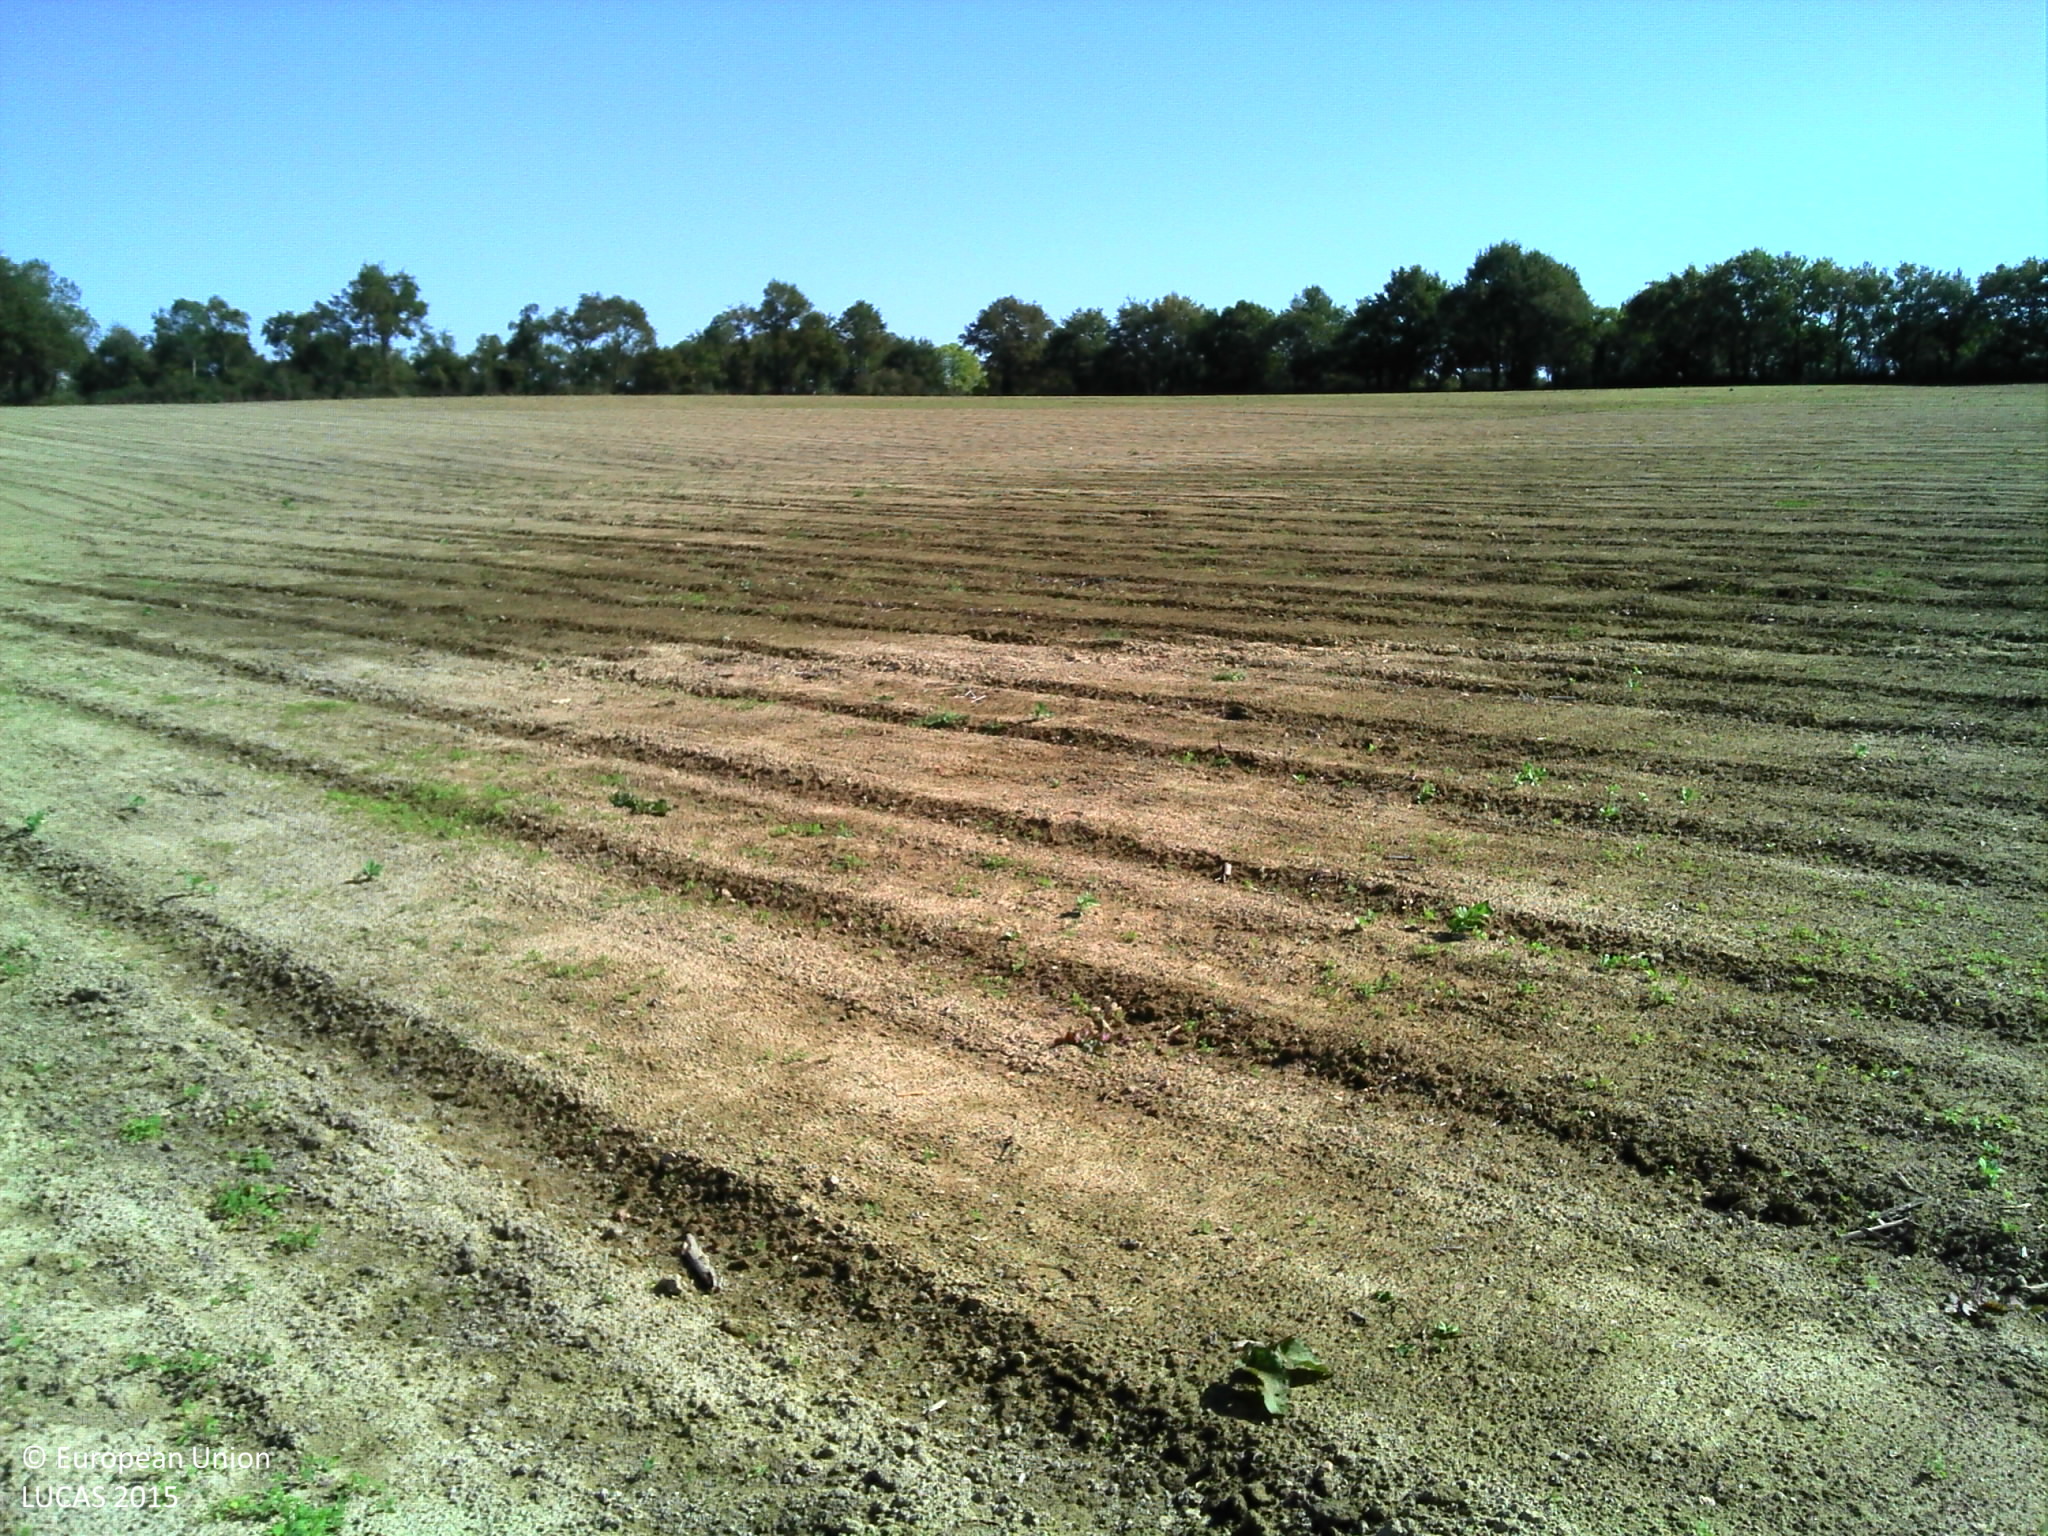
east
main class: Cropland
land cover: Dry pulses
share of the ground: > 75 %
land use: Agriculture (excluding fallow land and kitchen gardens)
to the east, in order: Dry pulses
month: September
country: FR
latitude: 46.5990
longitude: -1.3543
